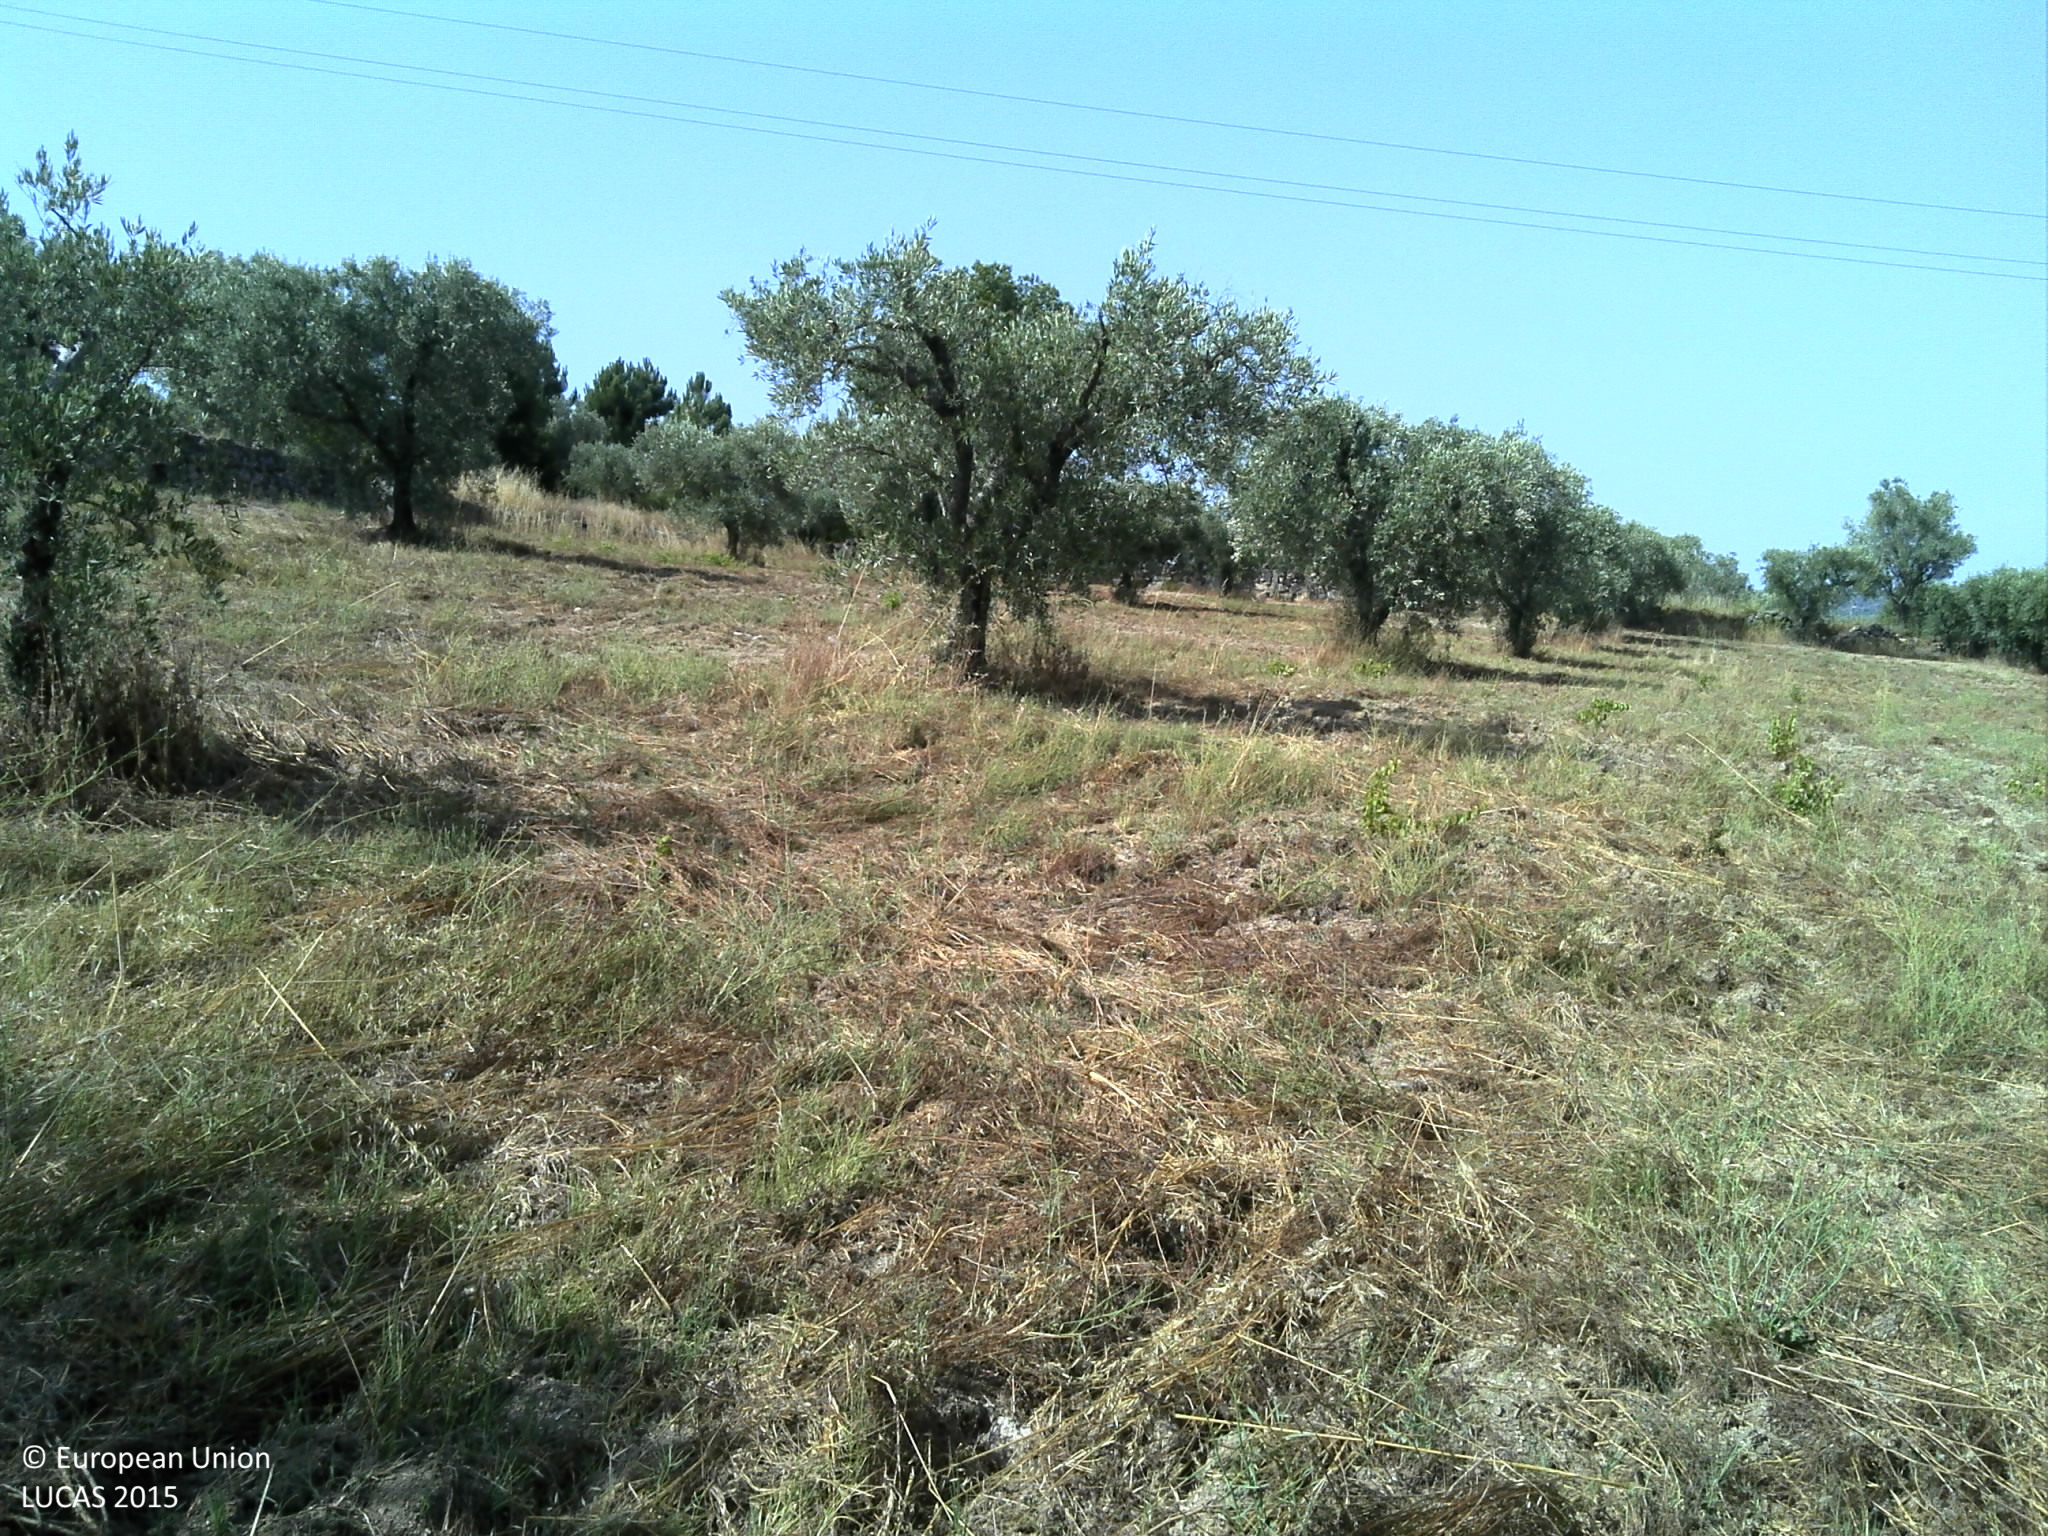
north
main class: Cropland
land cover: Olive groves
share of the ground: < 10 %
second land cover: Spontaneously vegetated surfaces
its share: 25 - 50 %
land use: Agriculture (excluding fallow land and kitchen gardens)
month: July
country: PT
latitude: 40.9249
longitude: -7.5397
